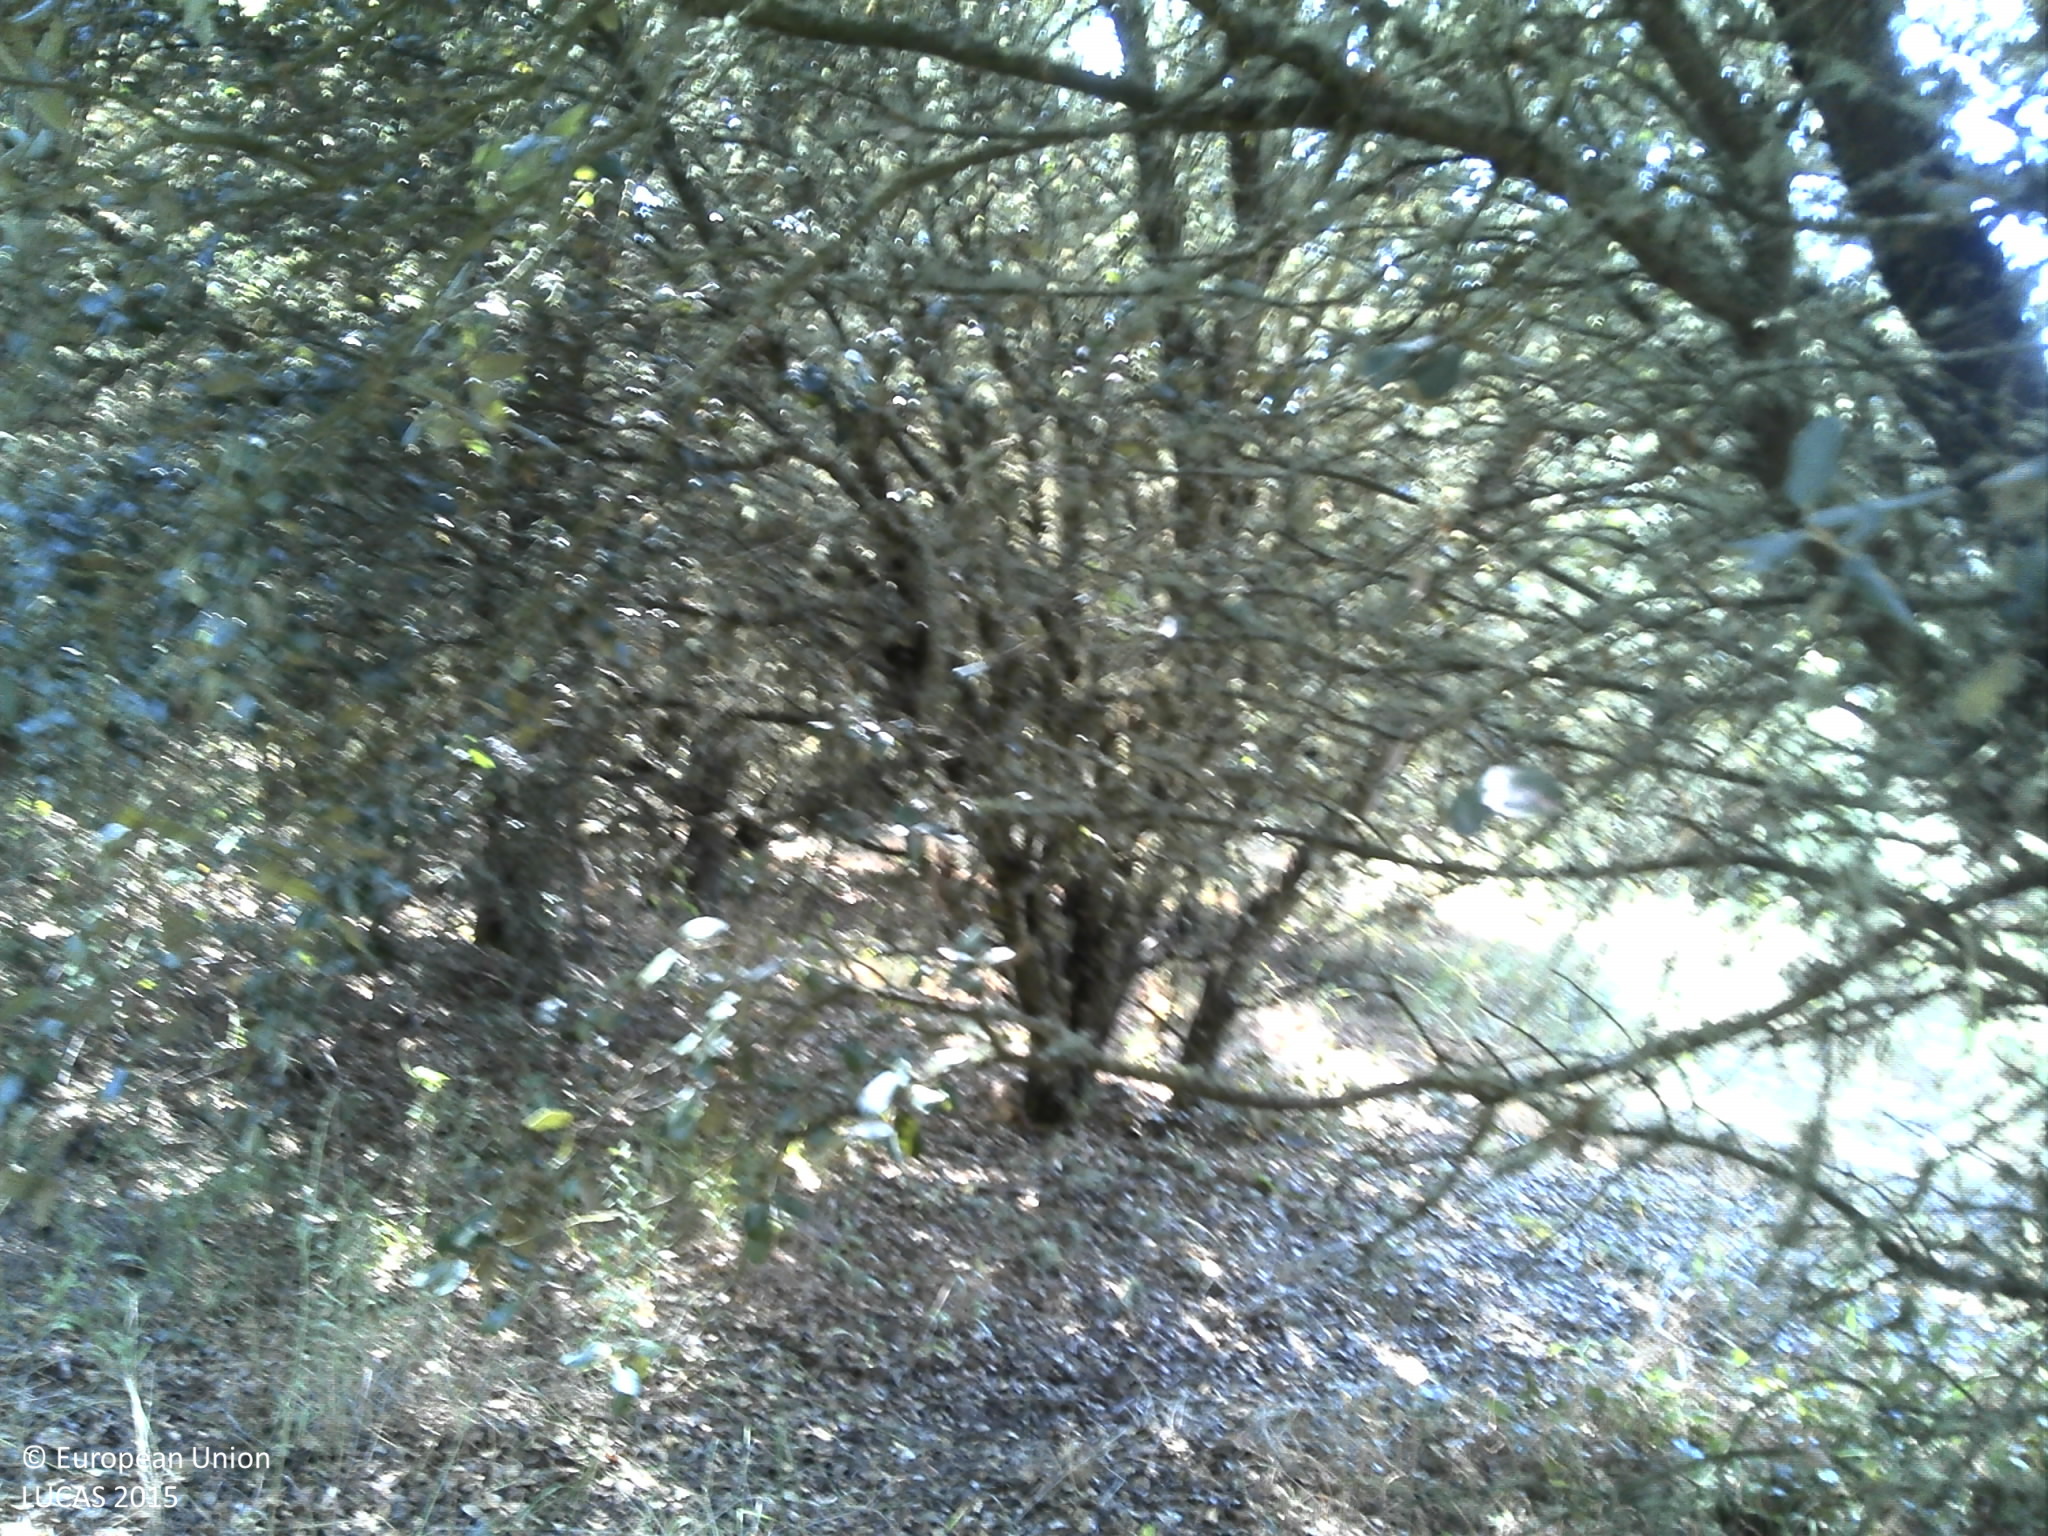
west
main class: Woodland
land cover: Broadleaved woodland
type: broadleaved evergreen forest
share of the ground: 25 - 50 %
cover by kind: shrubs 40 %, herbaceous plants 30 %, broadleaved forest trees 25 %, unconsolidated bare surface 5 %
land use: Forestry
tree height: > 5 m
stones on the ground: < 10 %
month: June
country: PT
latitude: 40.8556
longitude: -6.8875
